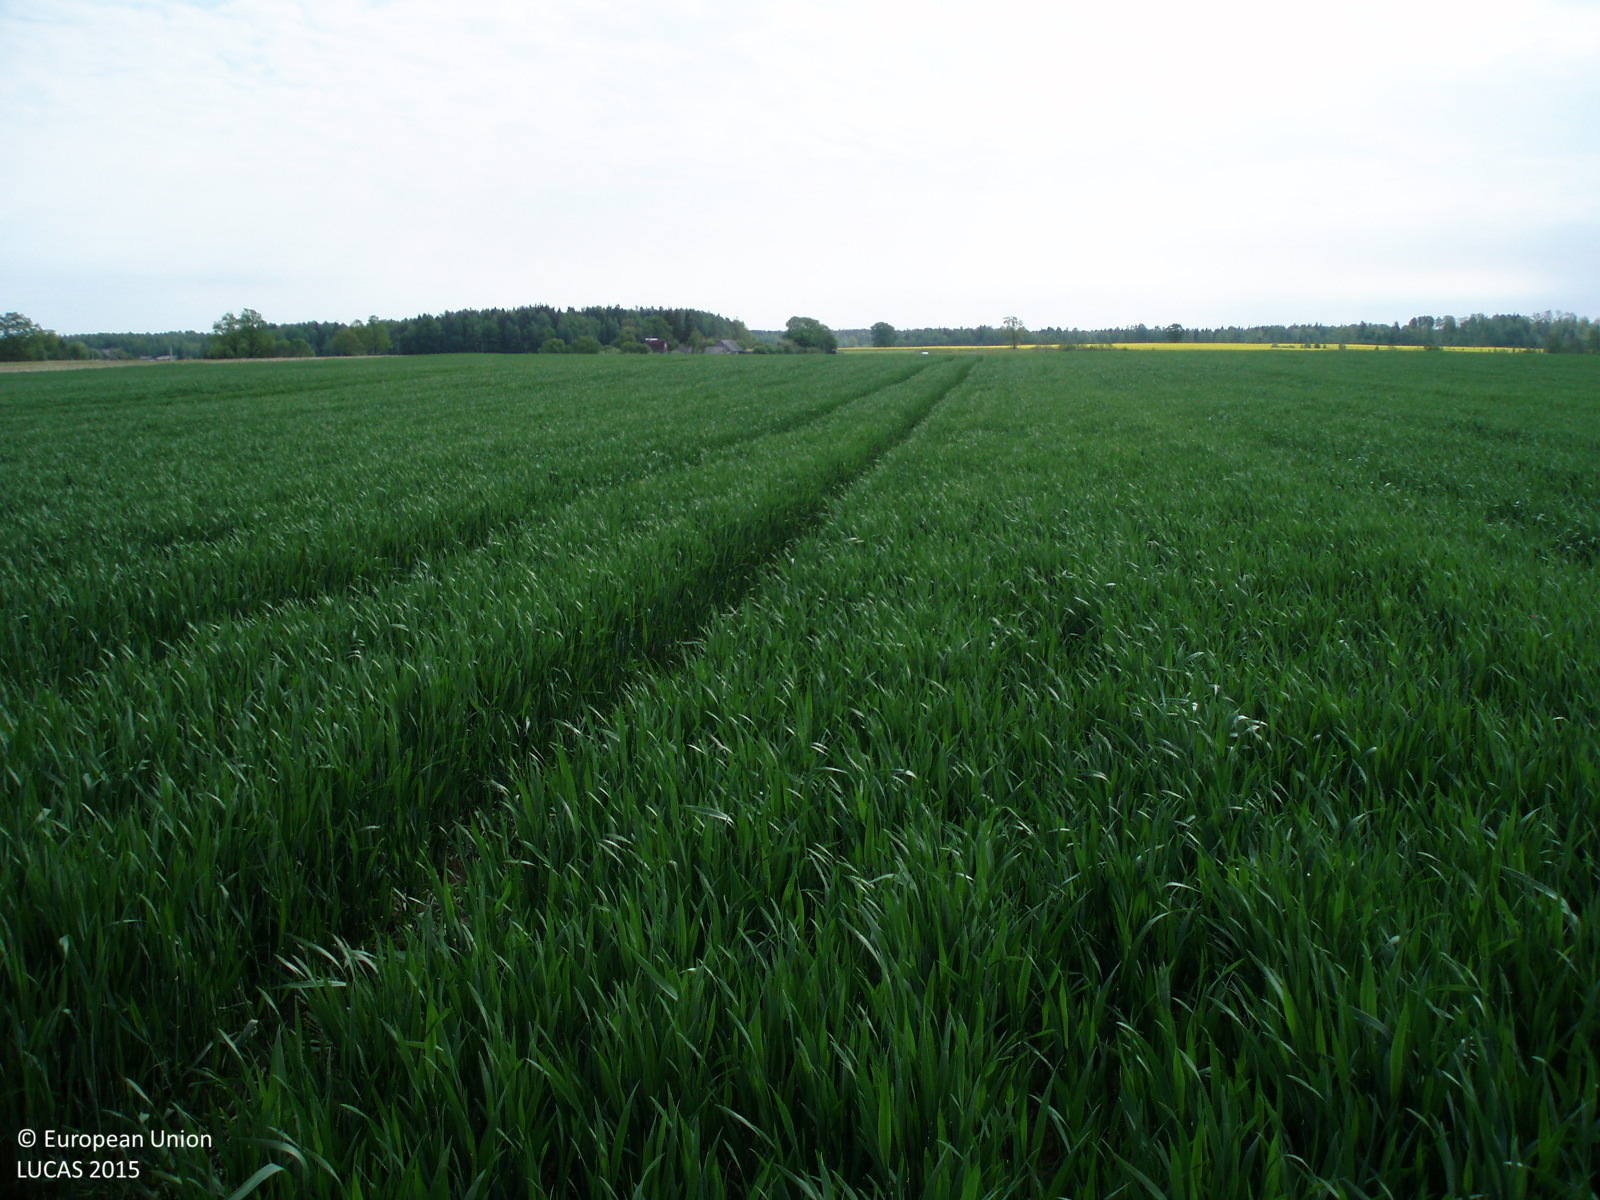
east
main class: Cropland
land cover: Common wheat
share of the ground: > 75 %
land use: Agriculture (excluding fallow land and kitchen gardens)
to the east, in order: Common wheat
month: May
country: LT
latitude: 56.1831
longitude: 22.4143
